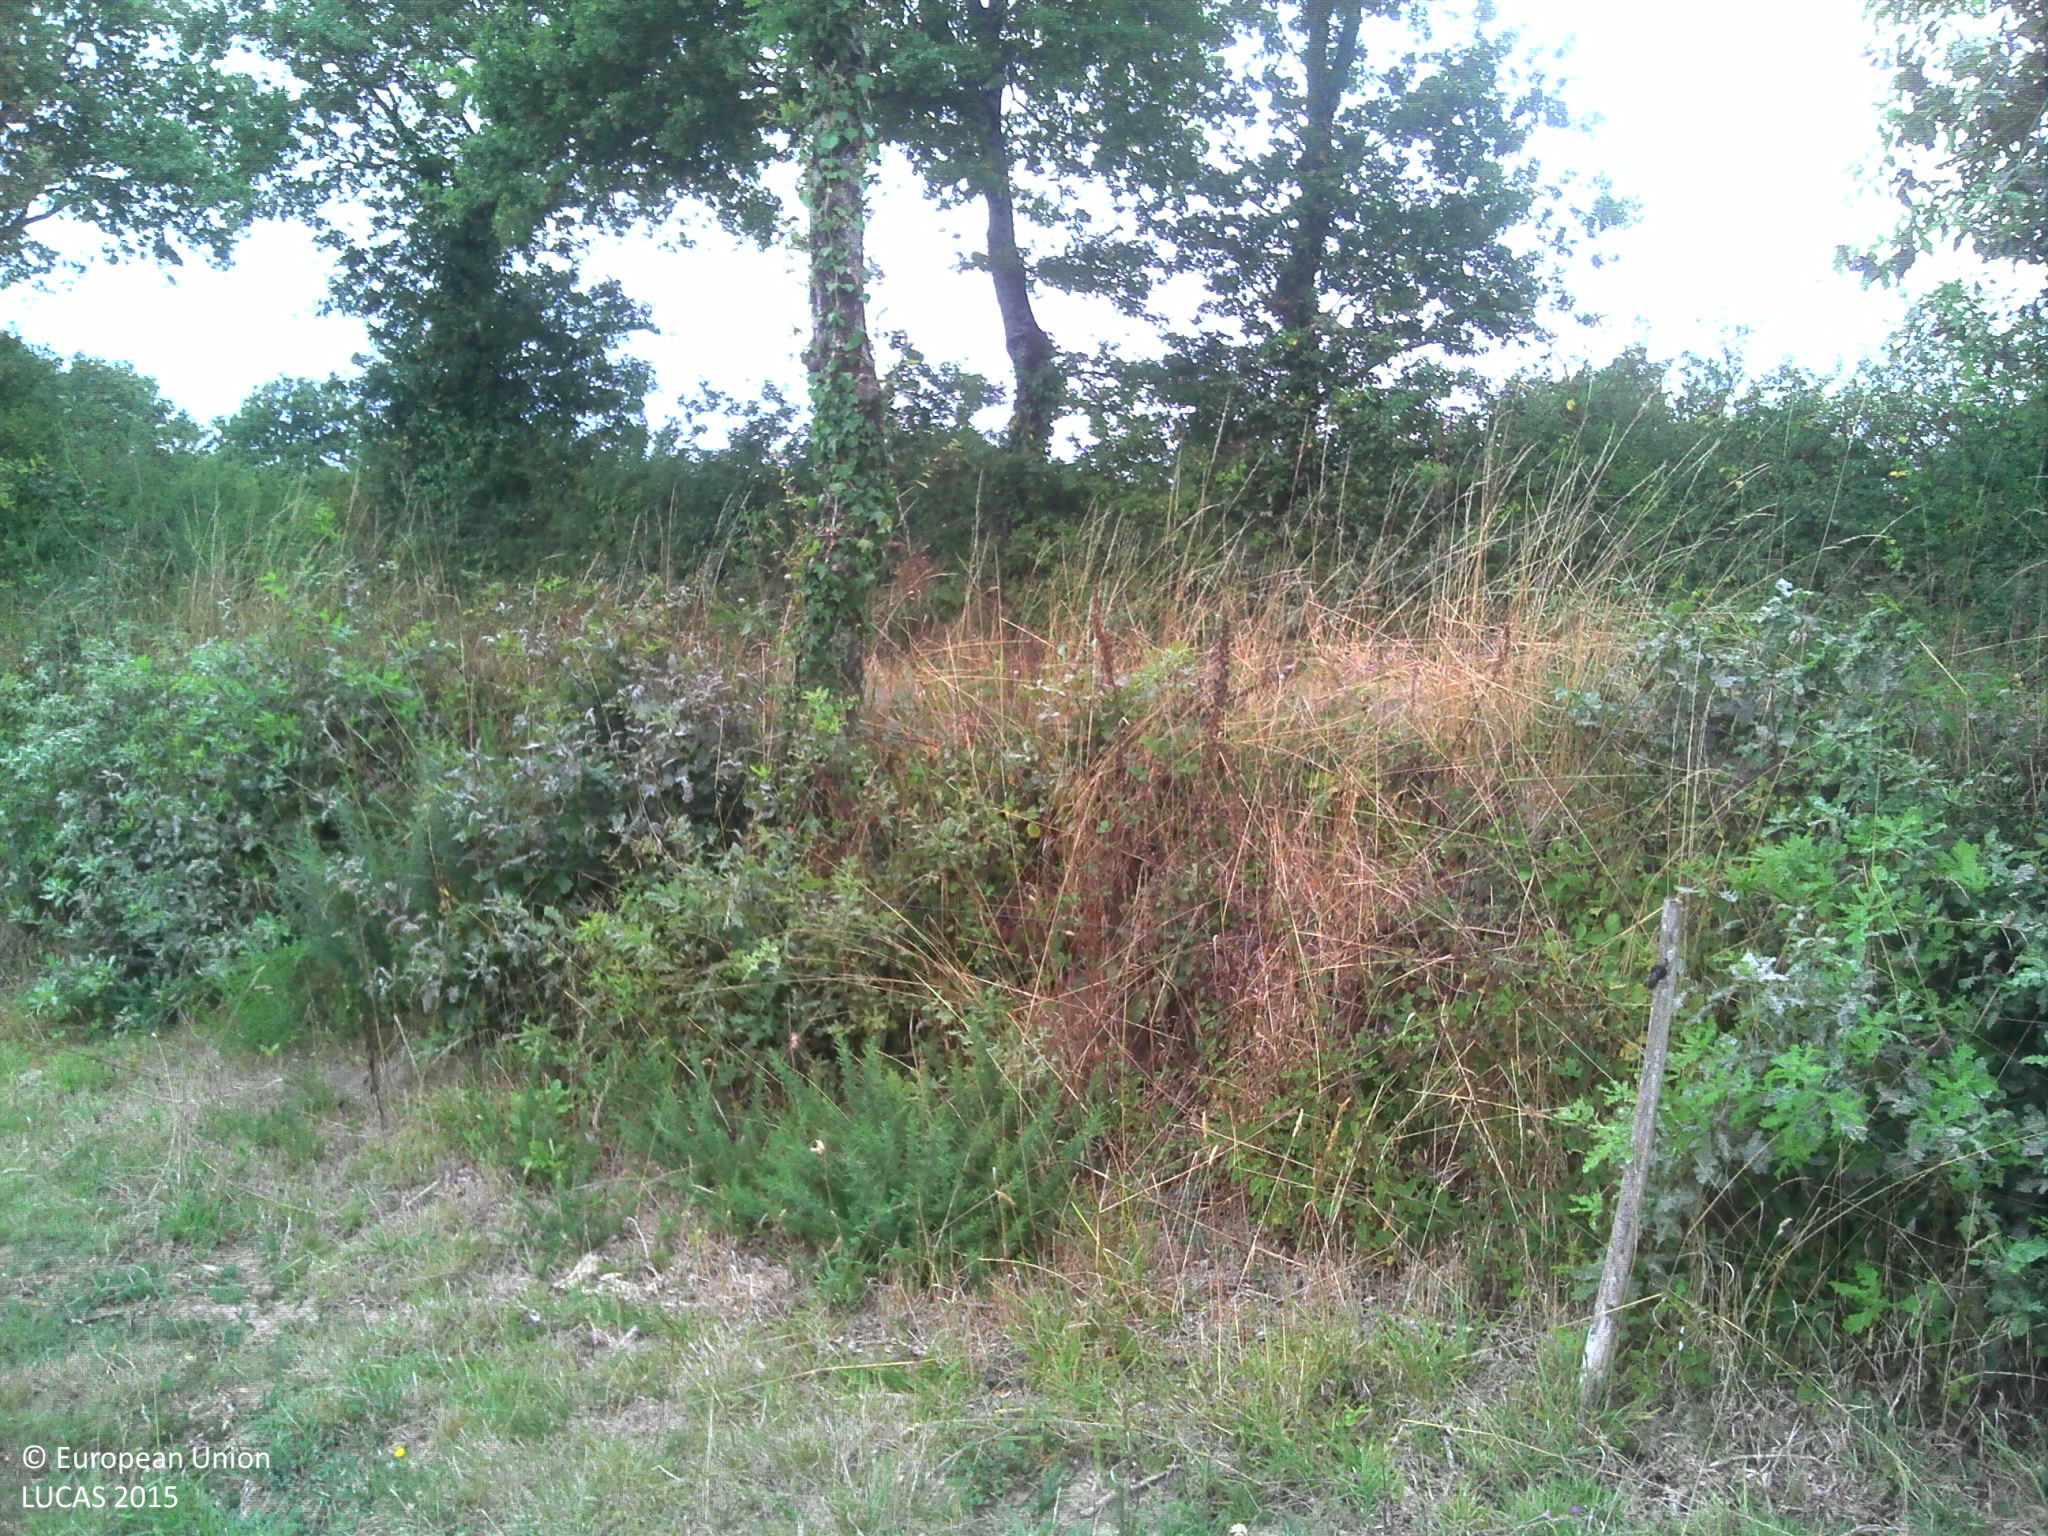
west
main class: Grassland
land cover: Grassland without tree/shrub cover
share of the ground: > 75 %
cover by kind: herbaceous plants 100 %
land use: Agriculture (excluding fallow land and kitchen gardens)
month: August
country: FR
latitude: 46.7189
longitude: -1.5922
